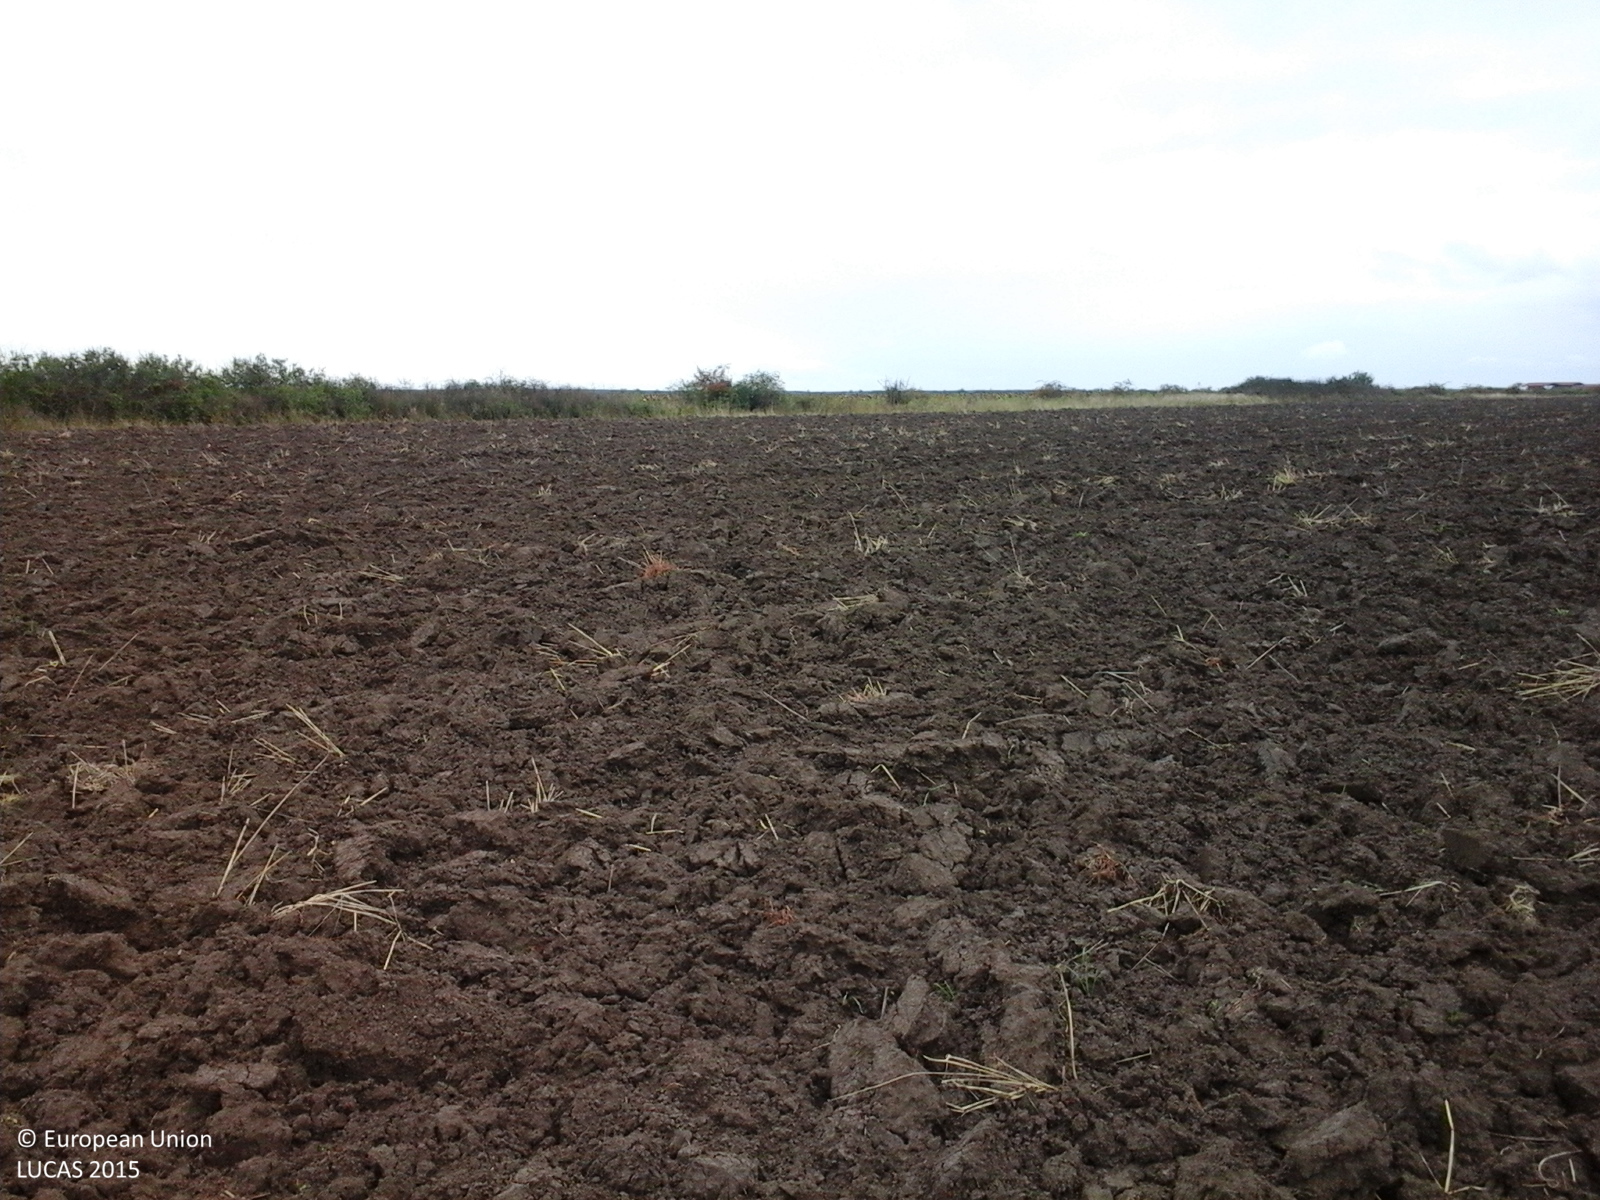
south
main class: Cropland
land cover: Common wheat
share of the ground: < 10 %
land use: Agriculture (excluding fallow land and kitchen gardens)
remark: Harvested field
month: September
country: RO
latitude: 46.8559
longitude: 21.8353
